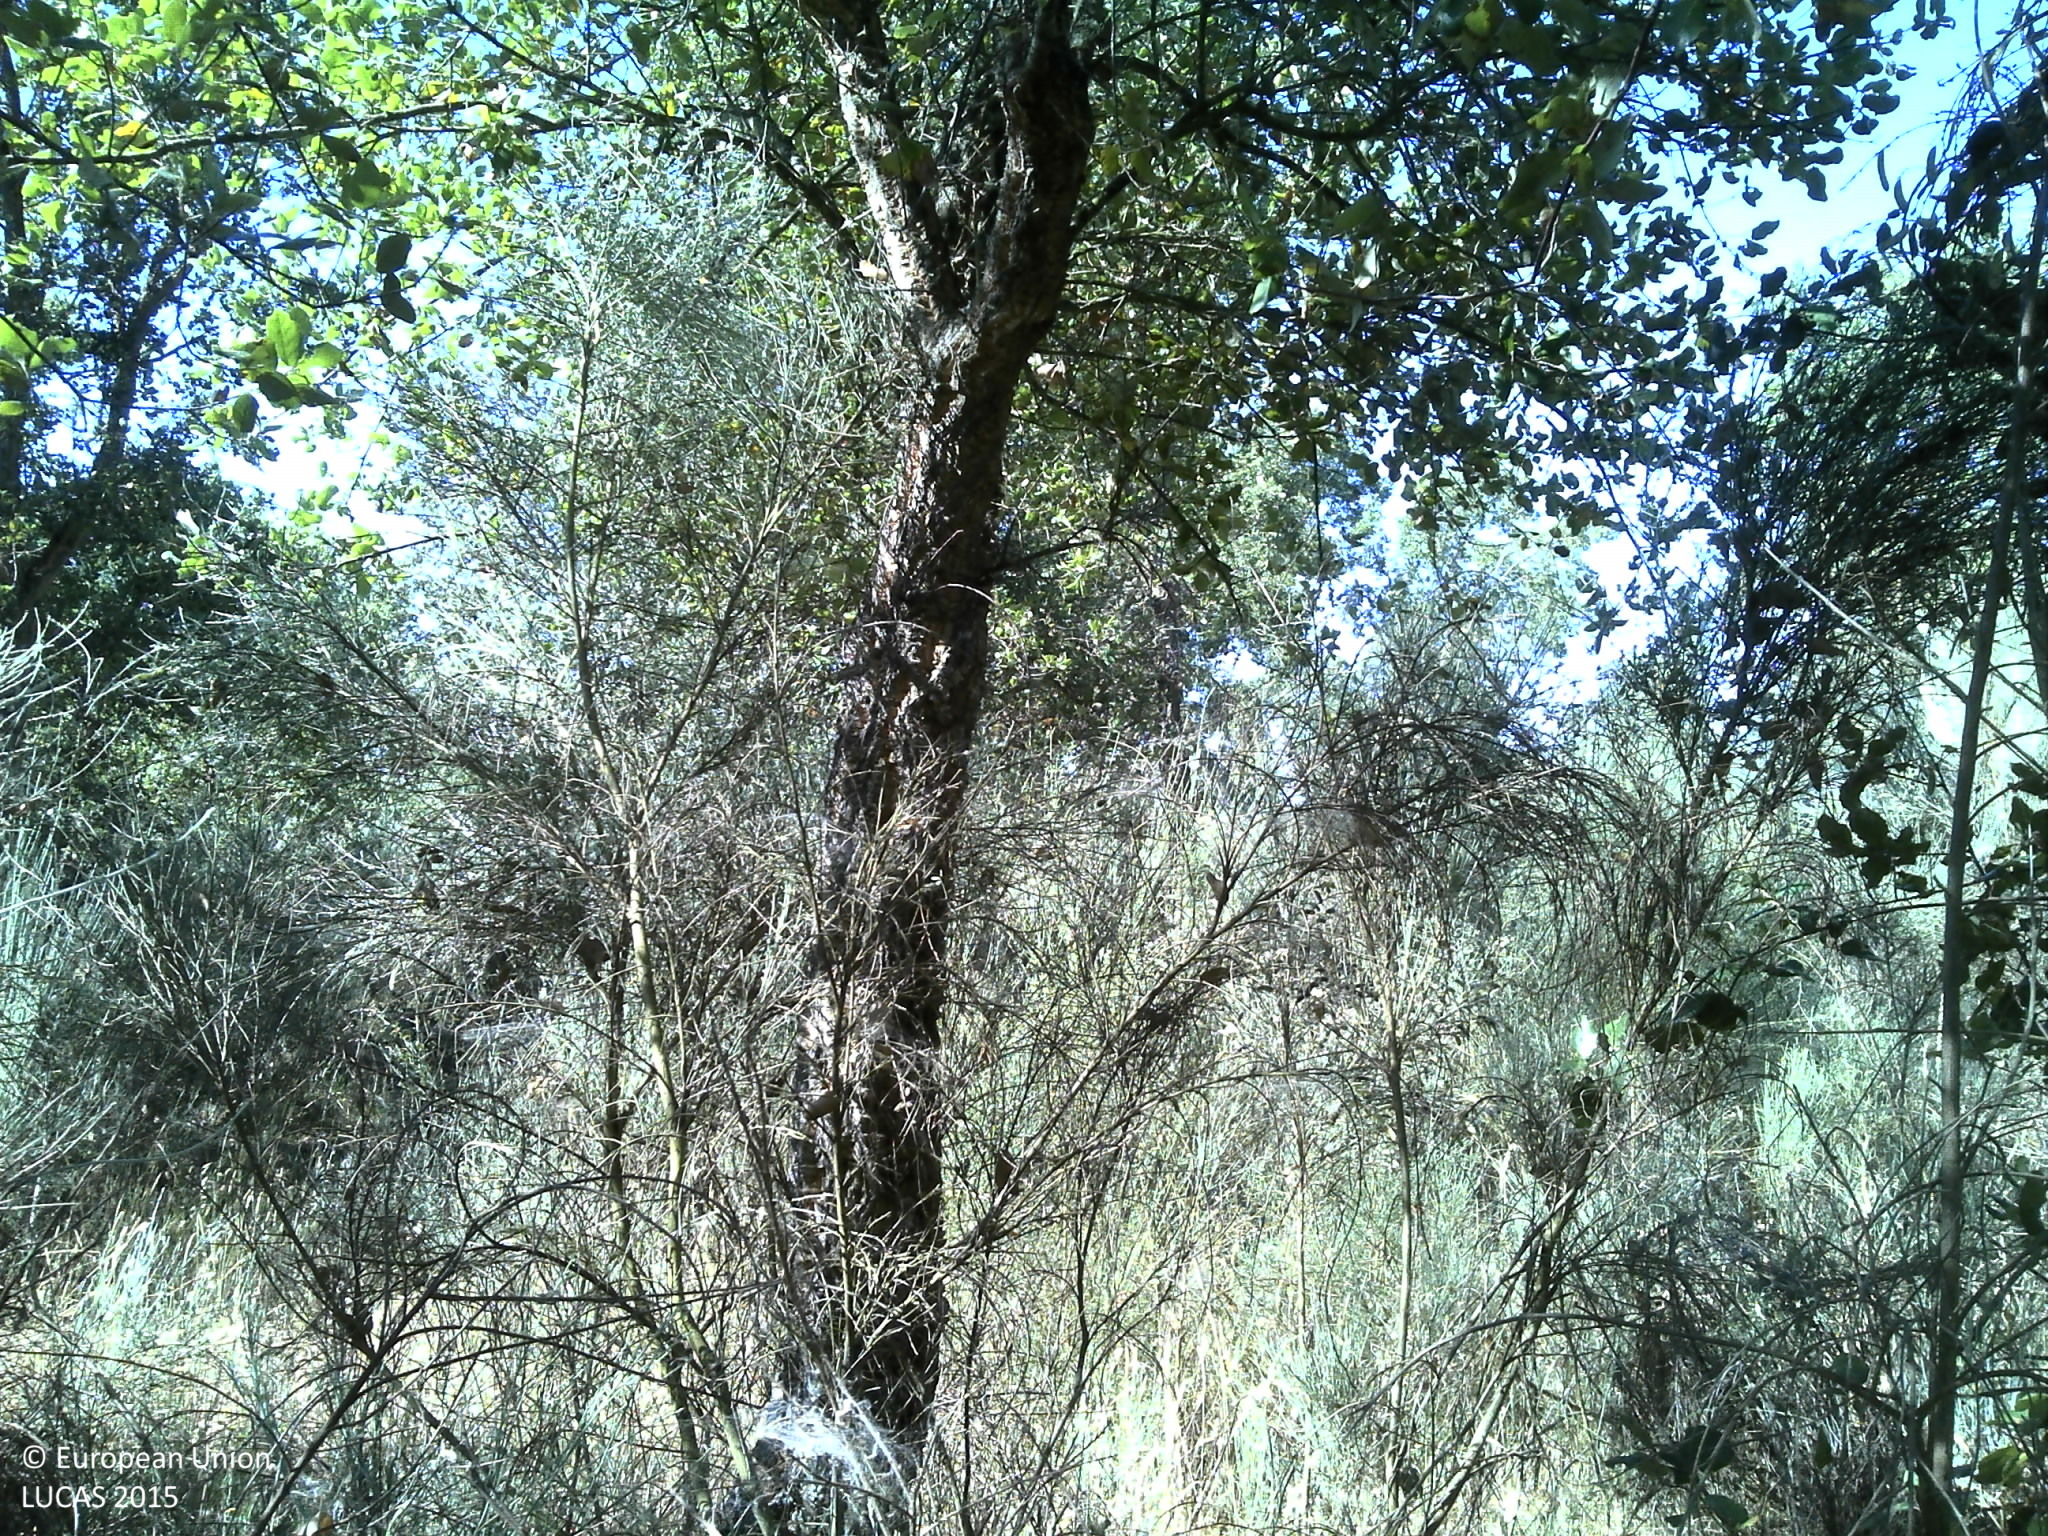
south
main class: Woodland
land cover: Broadleaved woodland
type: broadleaved evergreen forest
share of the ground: 25 - 50 %
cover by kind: shrubs 50 %, broadleaved forest trees 40 %, herbaceous plants 5 %, unconsolidated bare surface 5 %
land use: Forestry
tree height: > 5 m
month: May
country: PT
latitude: 39.4546
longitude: -7.6085
